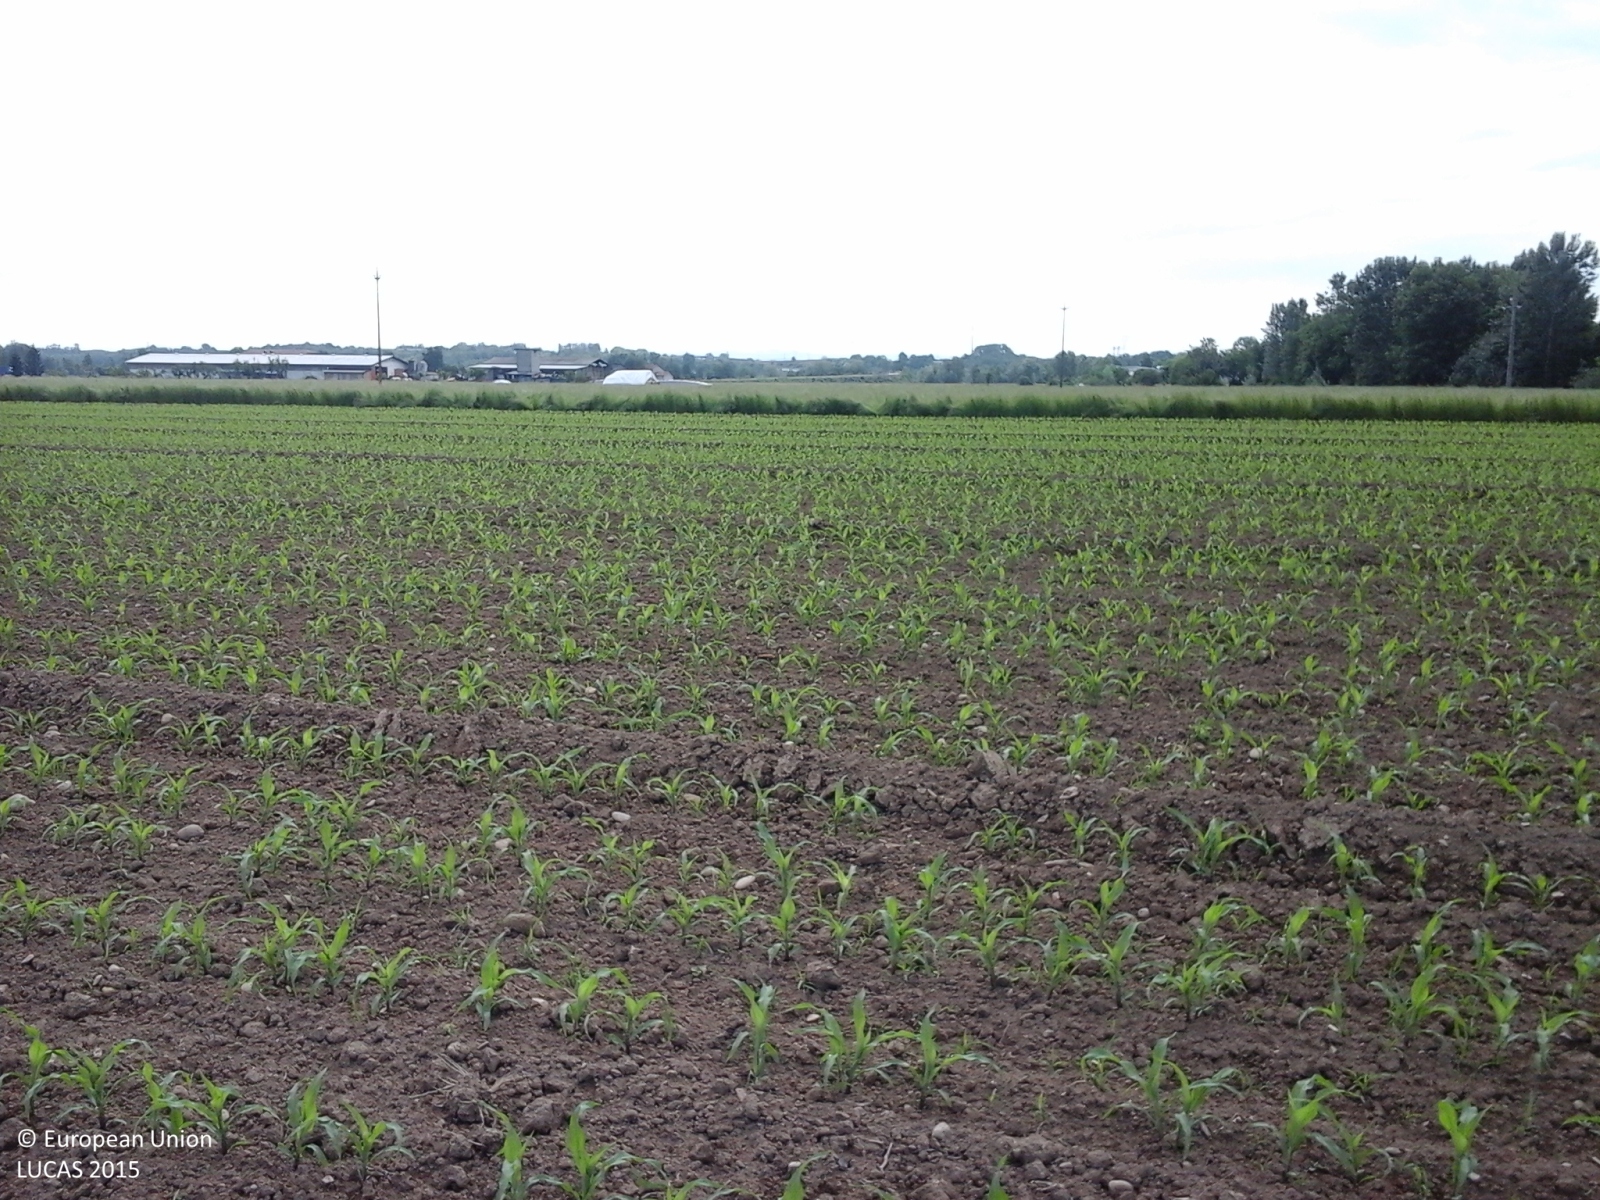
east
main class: Cropland
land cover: Maize
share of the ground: 10 - 25 %
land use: Agriculture (excluding fallow land and kitchen gardens)
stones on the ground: 10 - 25 %
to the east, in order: Maize; Temporary grasslands; Electric lines; Temporary grasslands; Ditches and canals; Tracks; Maize
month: May
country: IT
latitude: 44.4706
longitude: 7.7545
